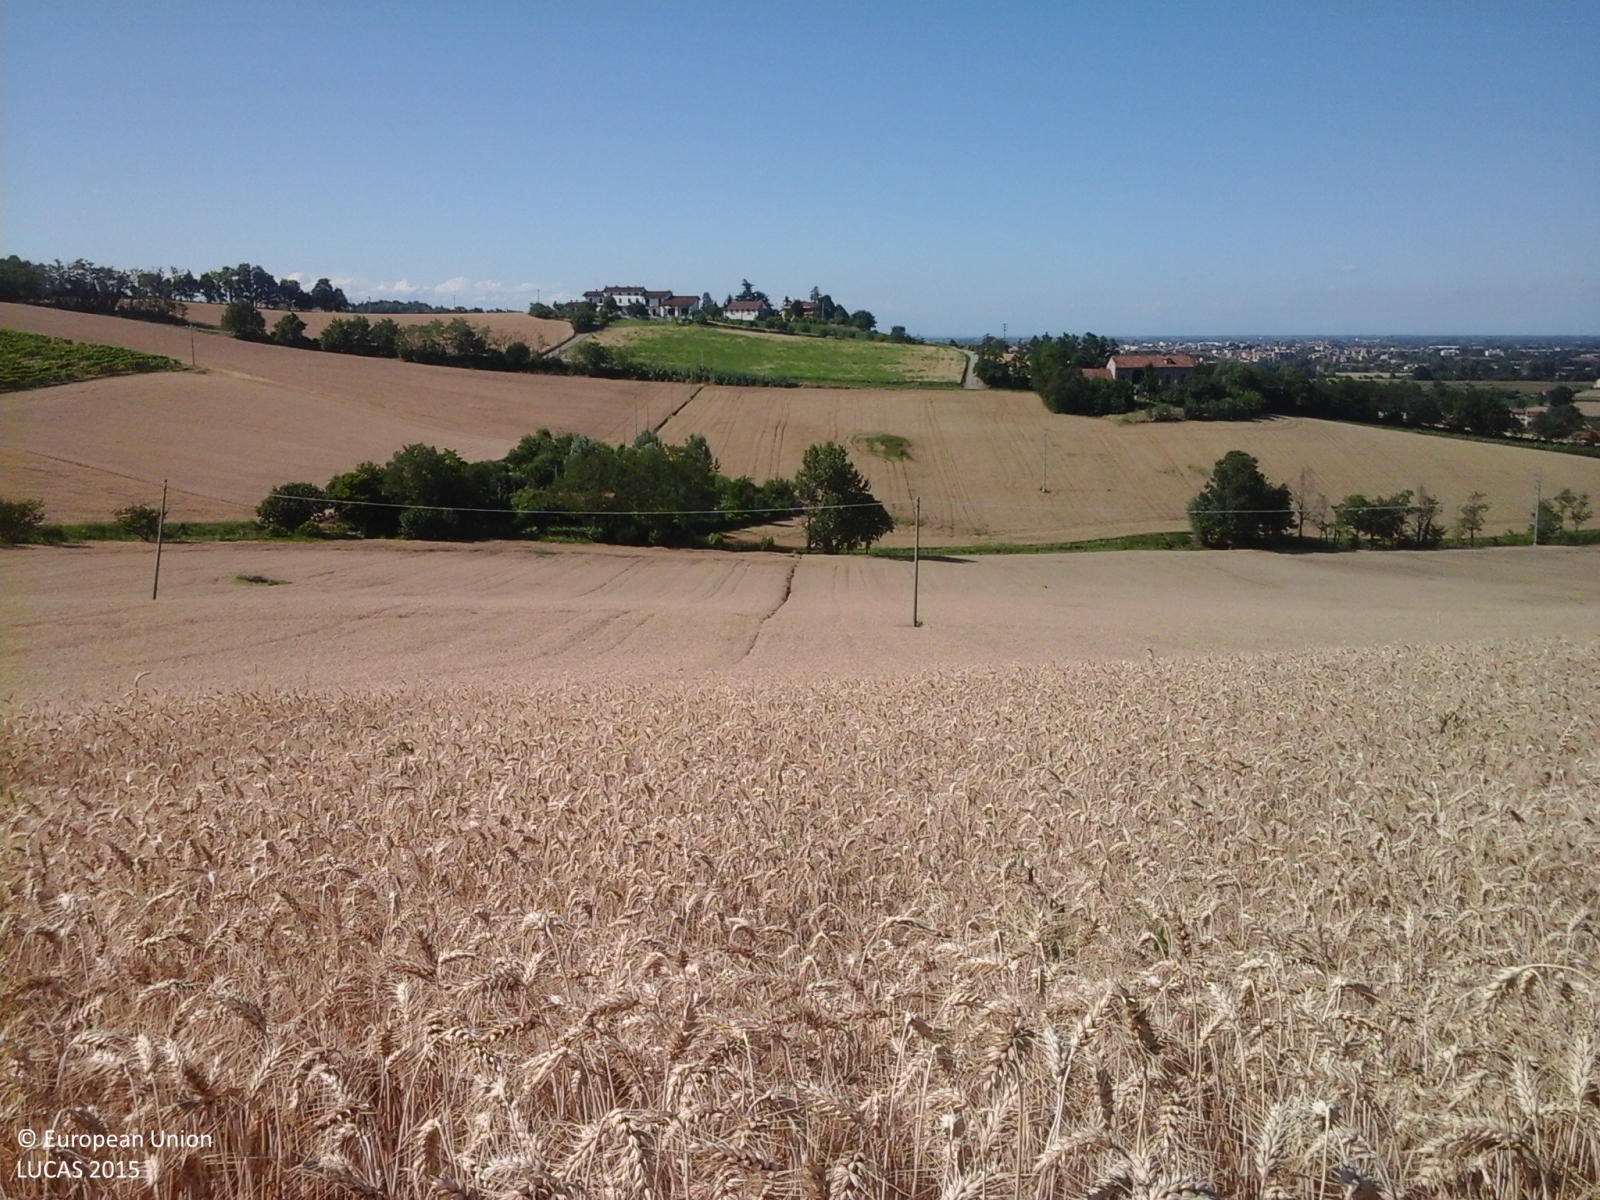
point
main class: Cropland
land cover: Common wheat
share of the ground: > 75 %
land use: Agriculture (excluding fallow land and kitchen gardens)
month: June
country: IT
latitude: 45.0963
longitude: 8.4399
